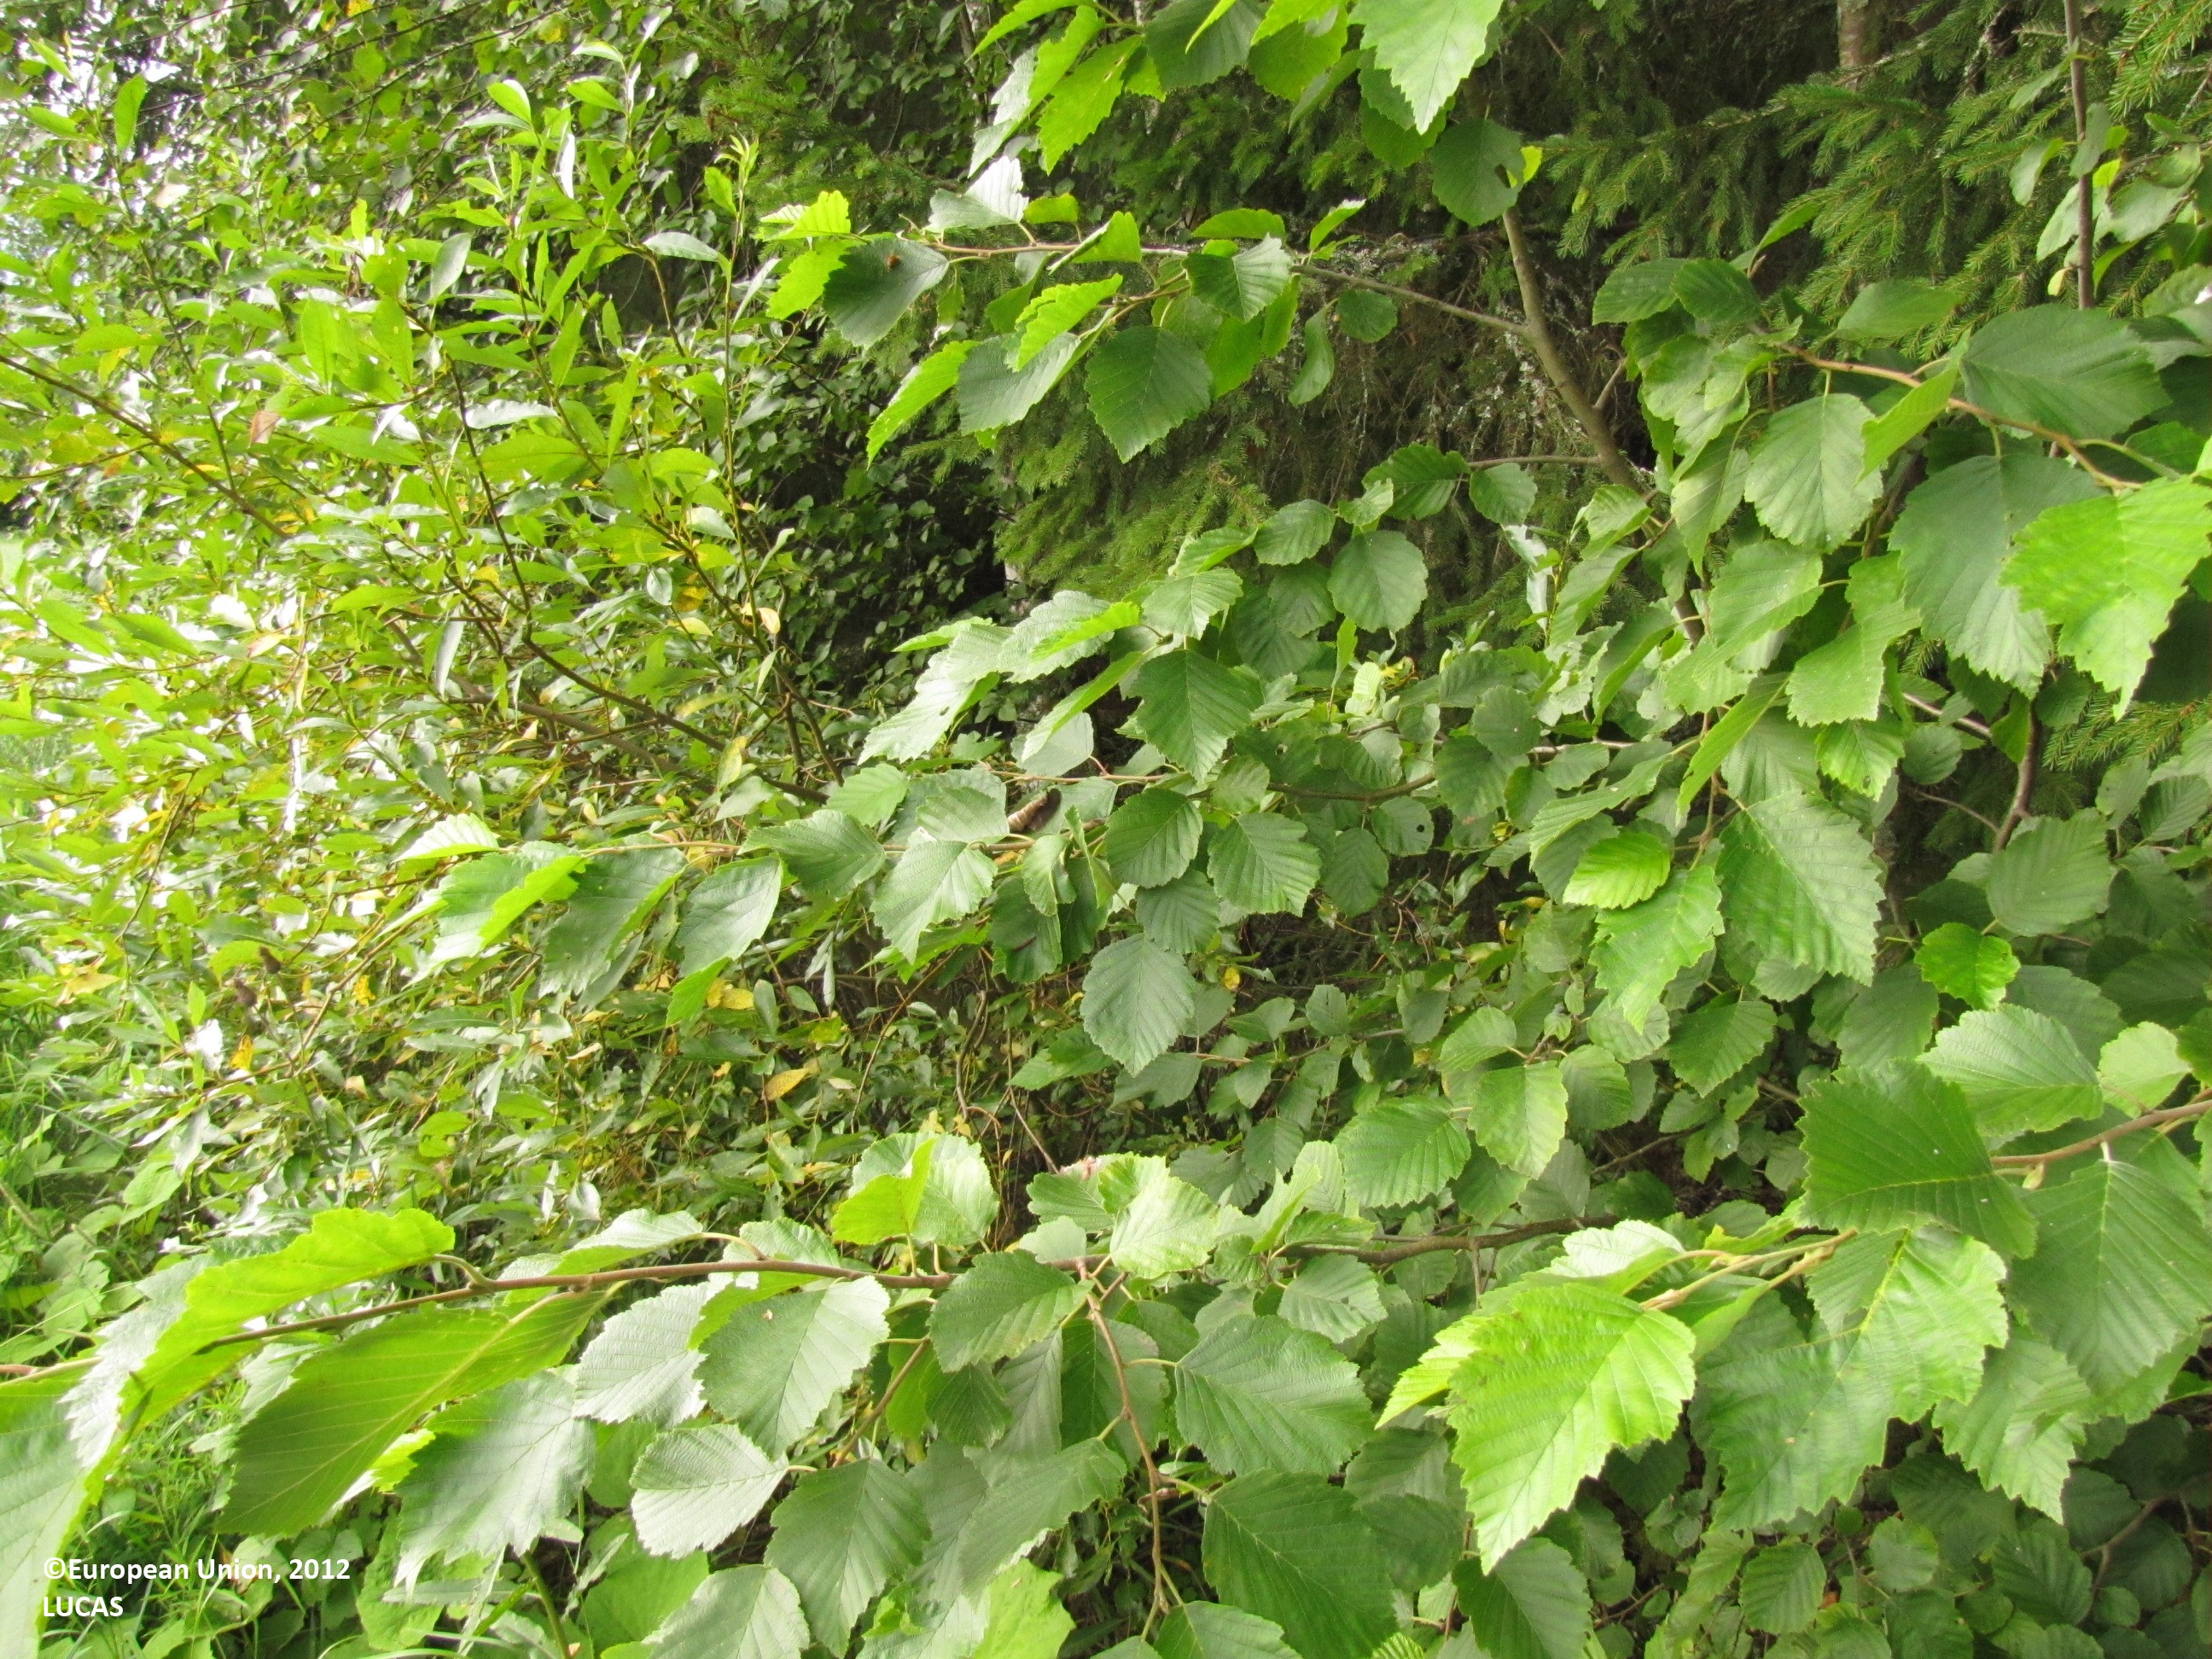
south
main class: Cropland
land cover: Oats
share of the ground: > 75 %
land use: Agriculture (excluding fallow land and kitchen gardens)
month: August
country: FI
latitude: 61.8119
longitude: 22.9532
